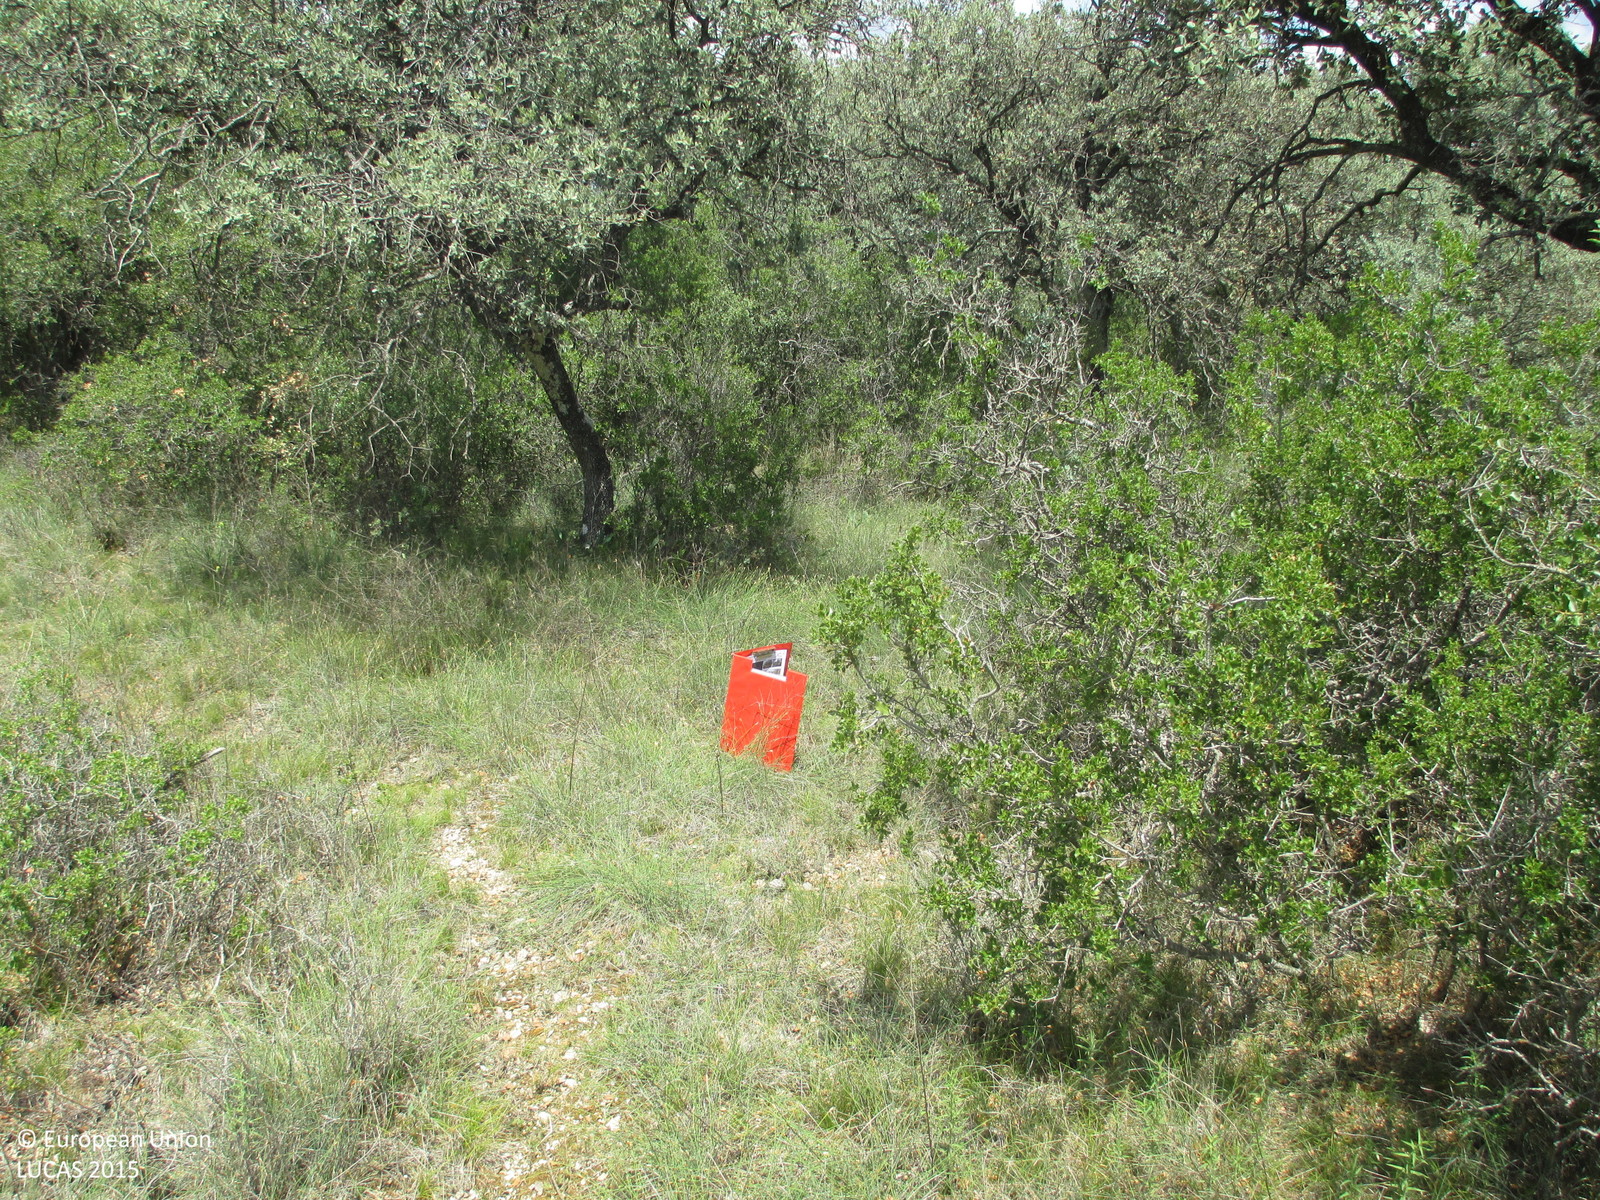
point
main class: Woodland
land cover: Broadleaved woodland
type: broadleaved evergreen forest
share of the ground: > 75 %
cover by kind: broadleaved forest trees 100 %
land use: Semi-natural and natural areas not in use
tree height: > 5 m
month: June
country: ES
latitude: 42.2004
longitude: -0.4752
